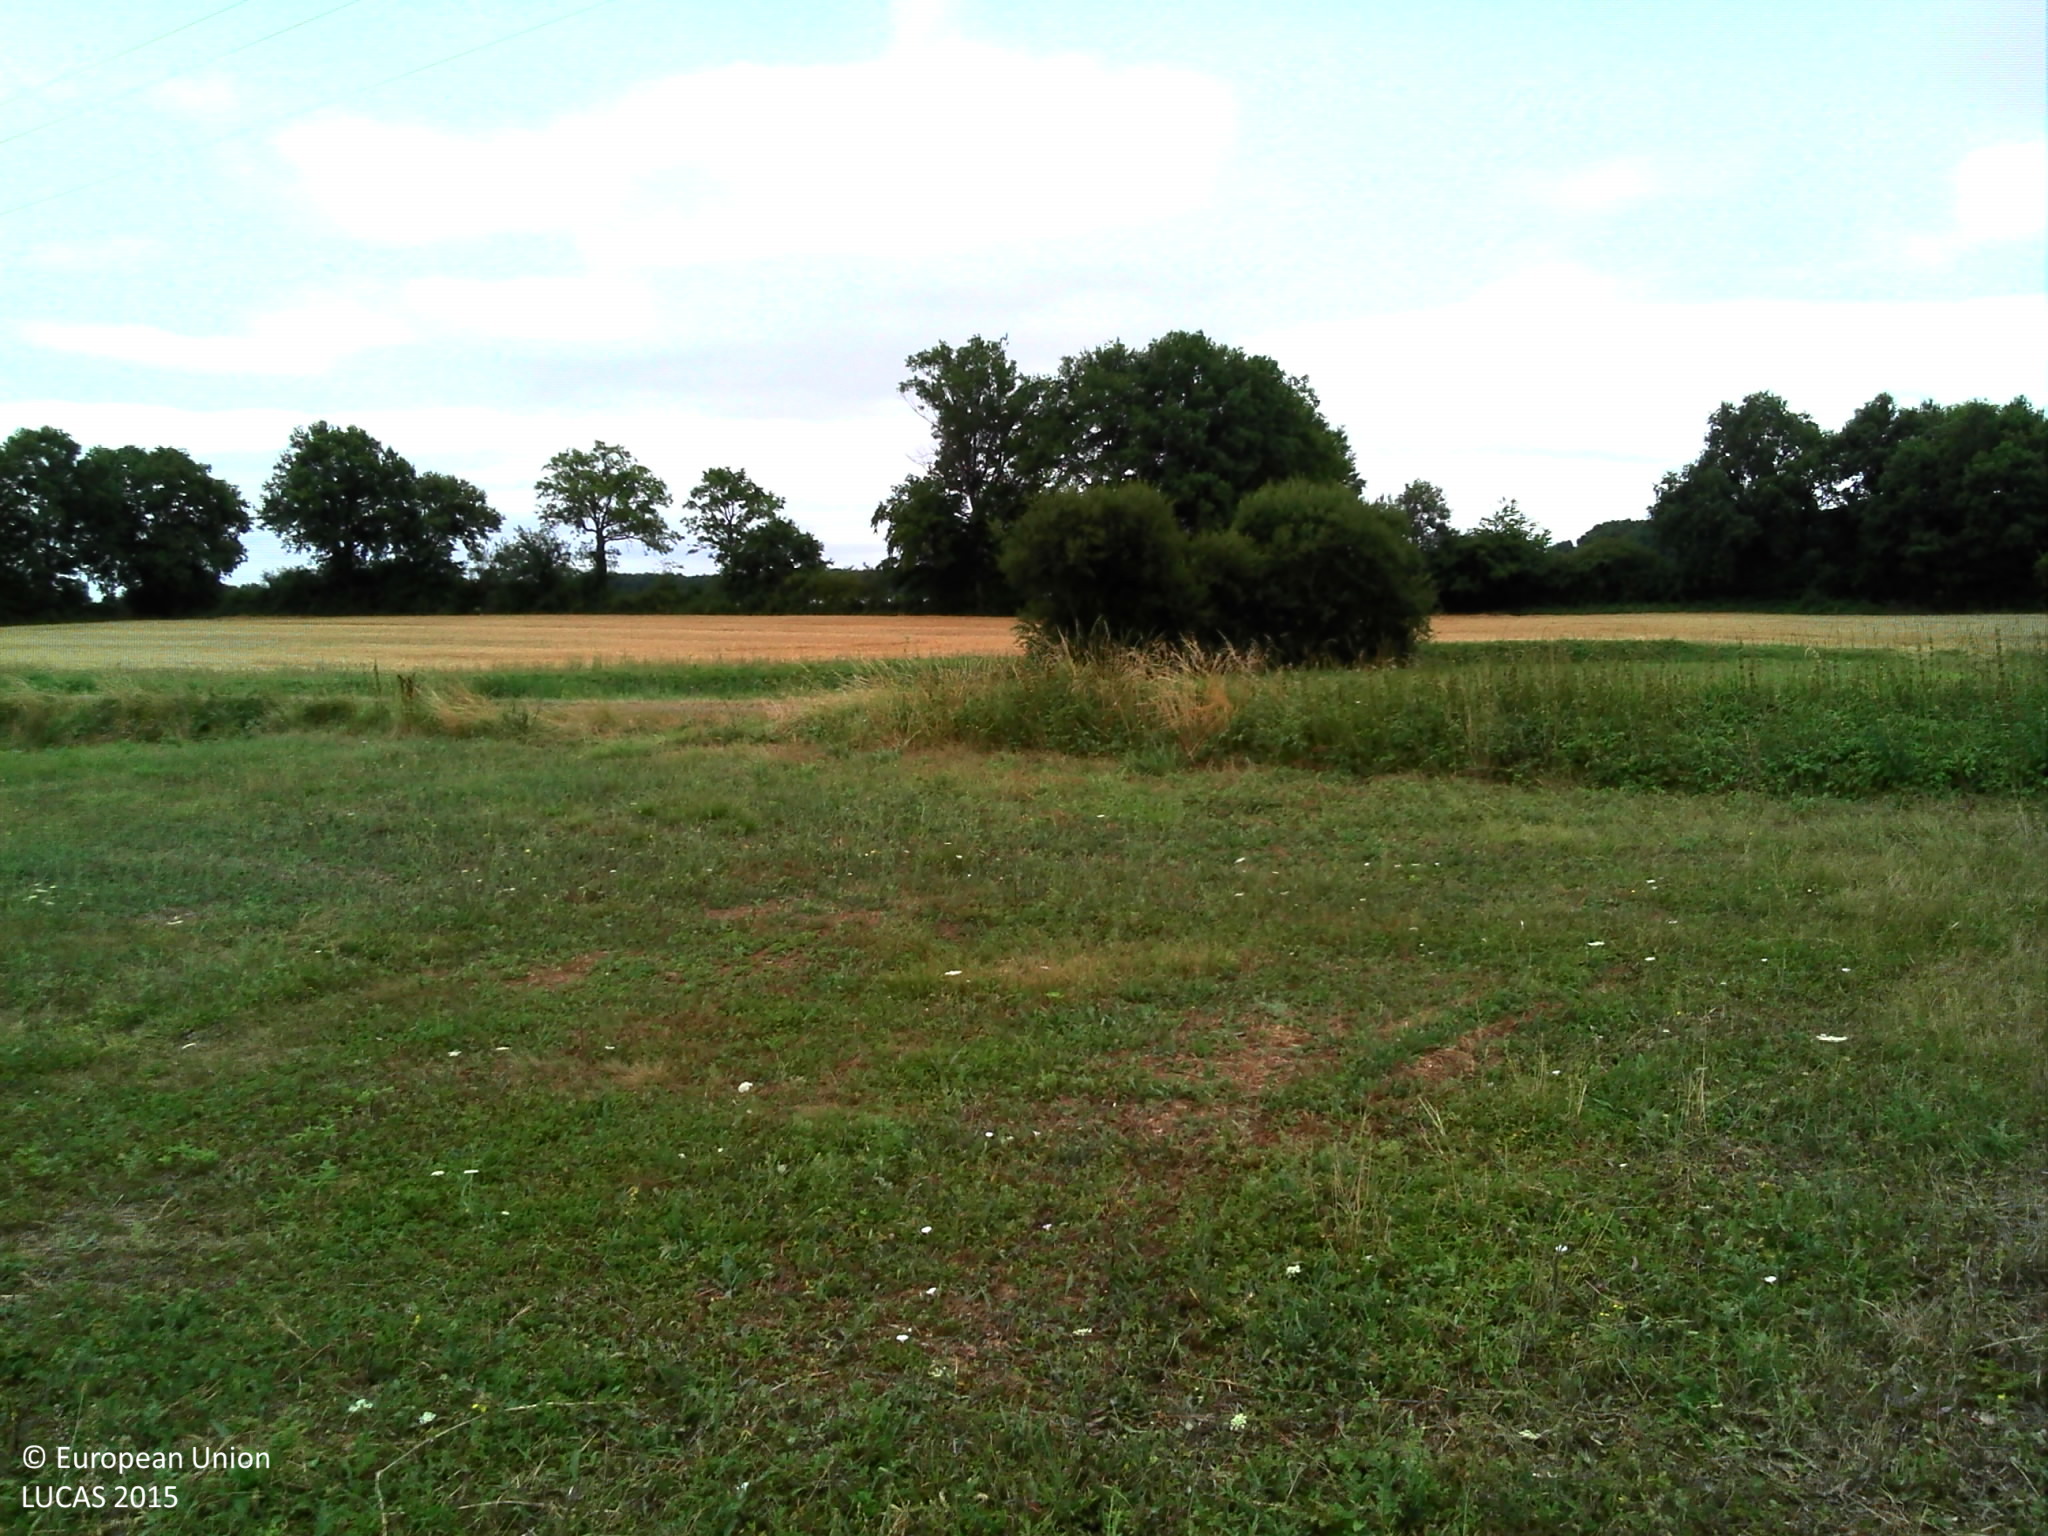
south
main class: Grassland
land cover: Grassland without tree/shrub cover
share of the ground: > 75 %
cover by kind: herbaceous plants 100 %
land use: Agriculture (excluding fallow land and kitchen gardens)
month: July
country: FR
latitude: 46.2430
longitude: 0.5816
